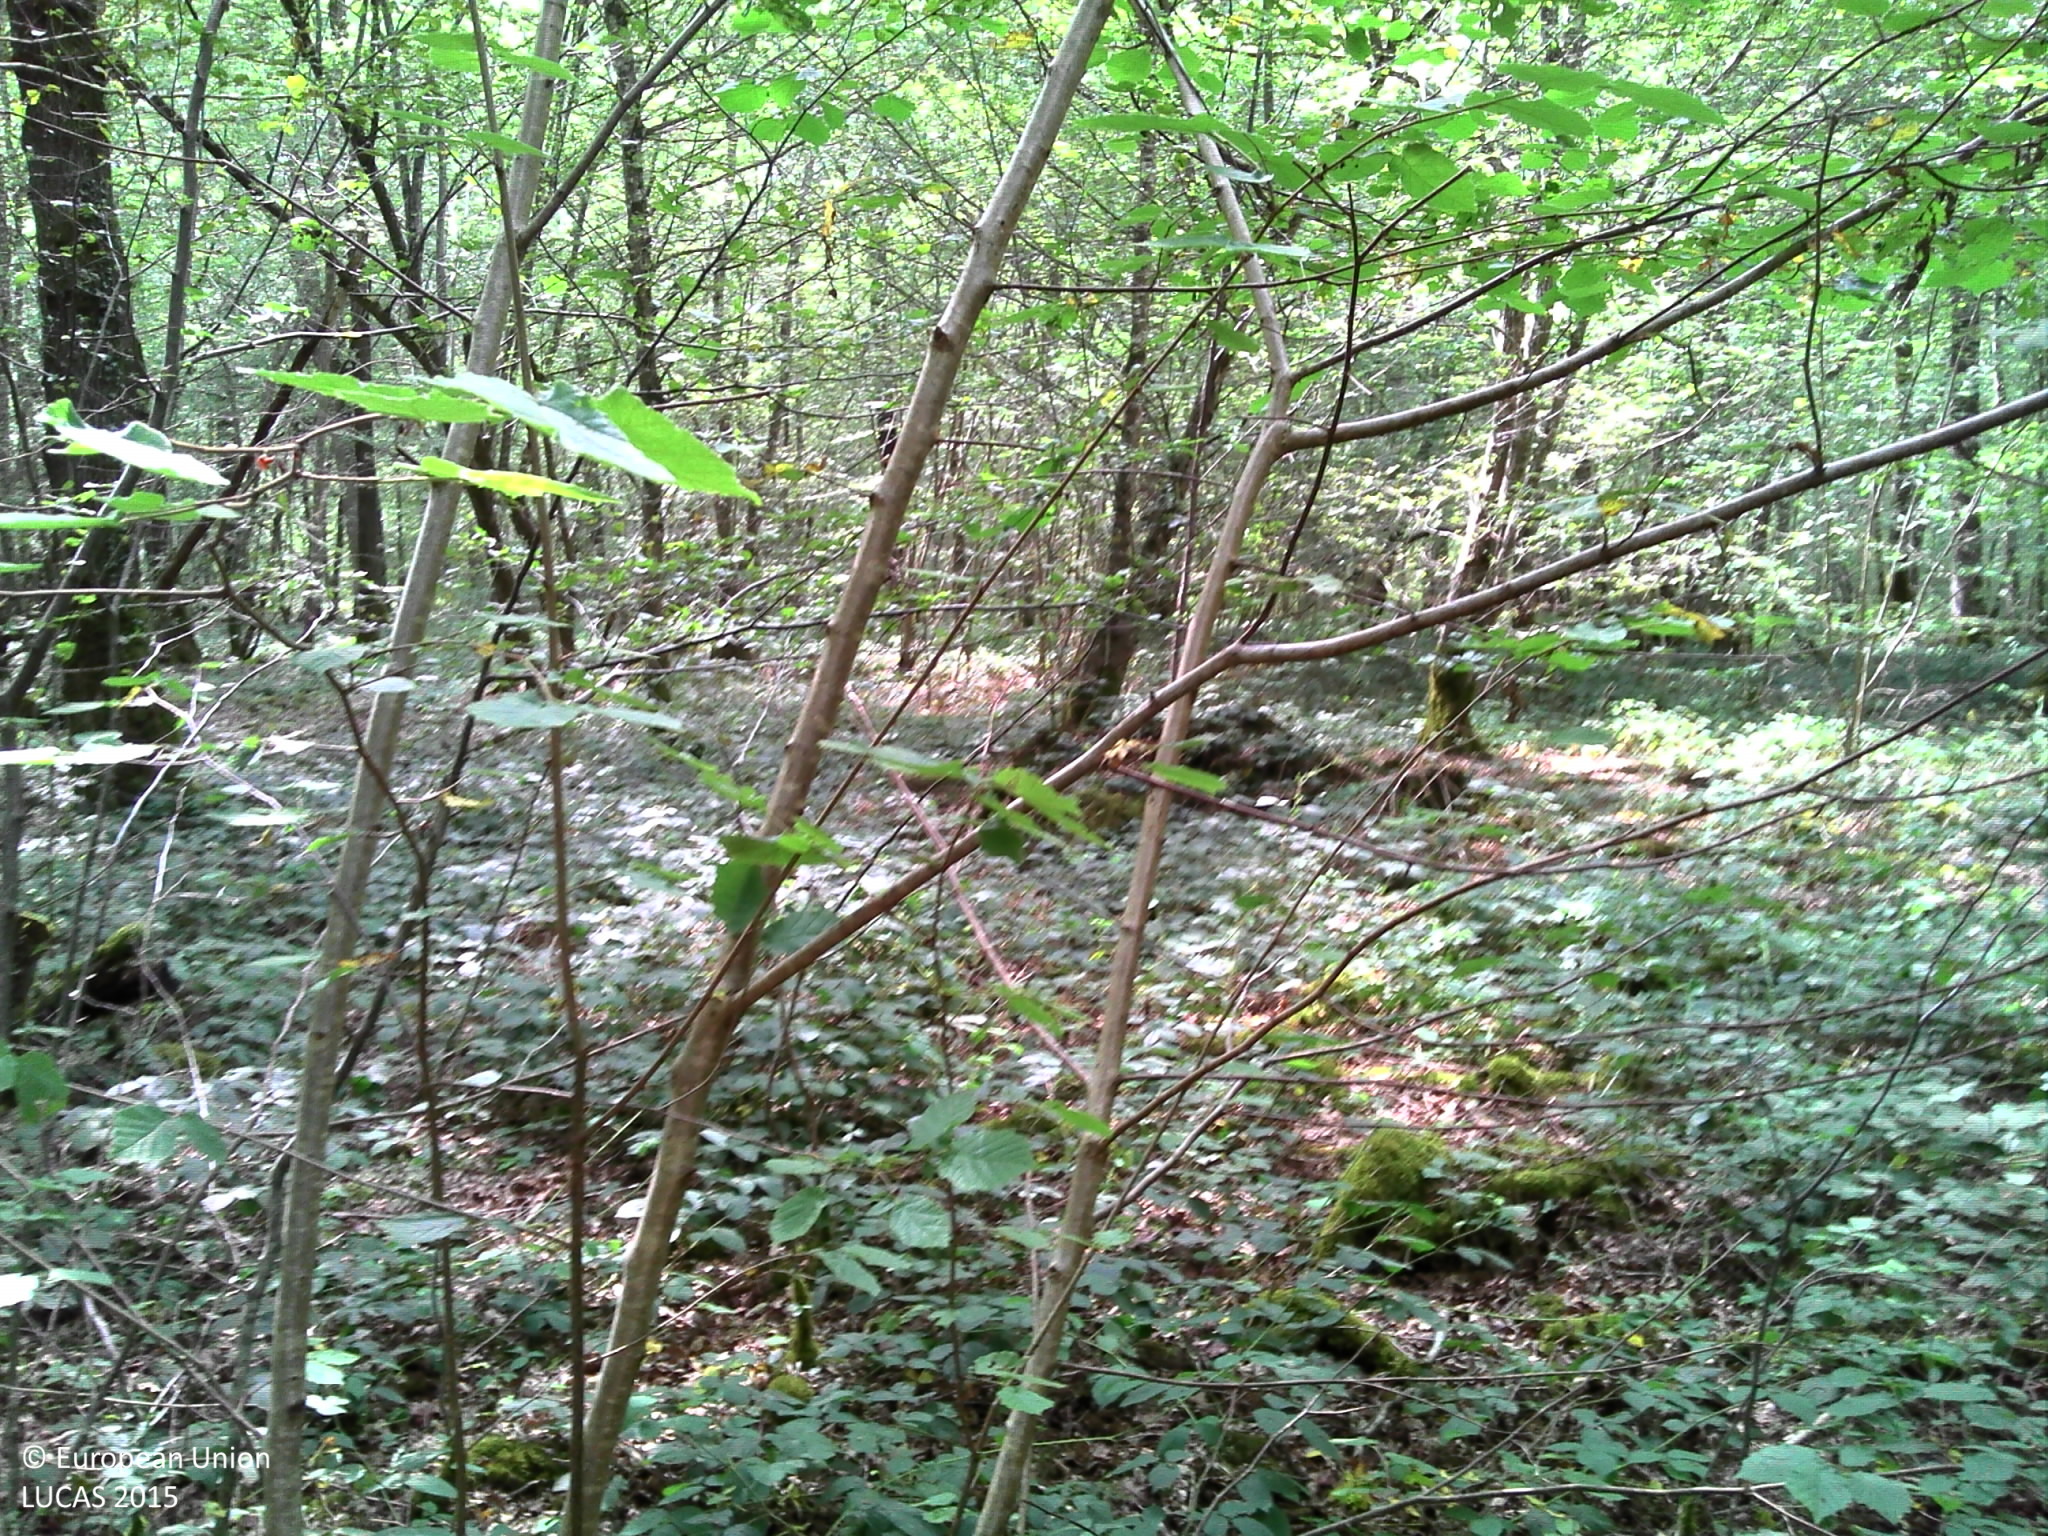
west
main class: Woodland
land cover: Broadleaved woodland
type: mesophytic deciduous forest
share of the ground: > 75 %
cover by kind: broadleaved forest trees 90 %, herbaceous plants 5 %, lichens and mosses 5 %
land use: Forestry
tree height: > 5 m
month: July
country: FR
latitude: 48.0766
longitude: 3.0536
